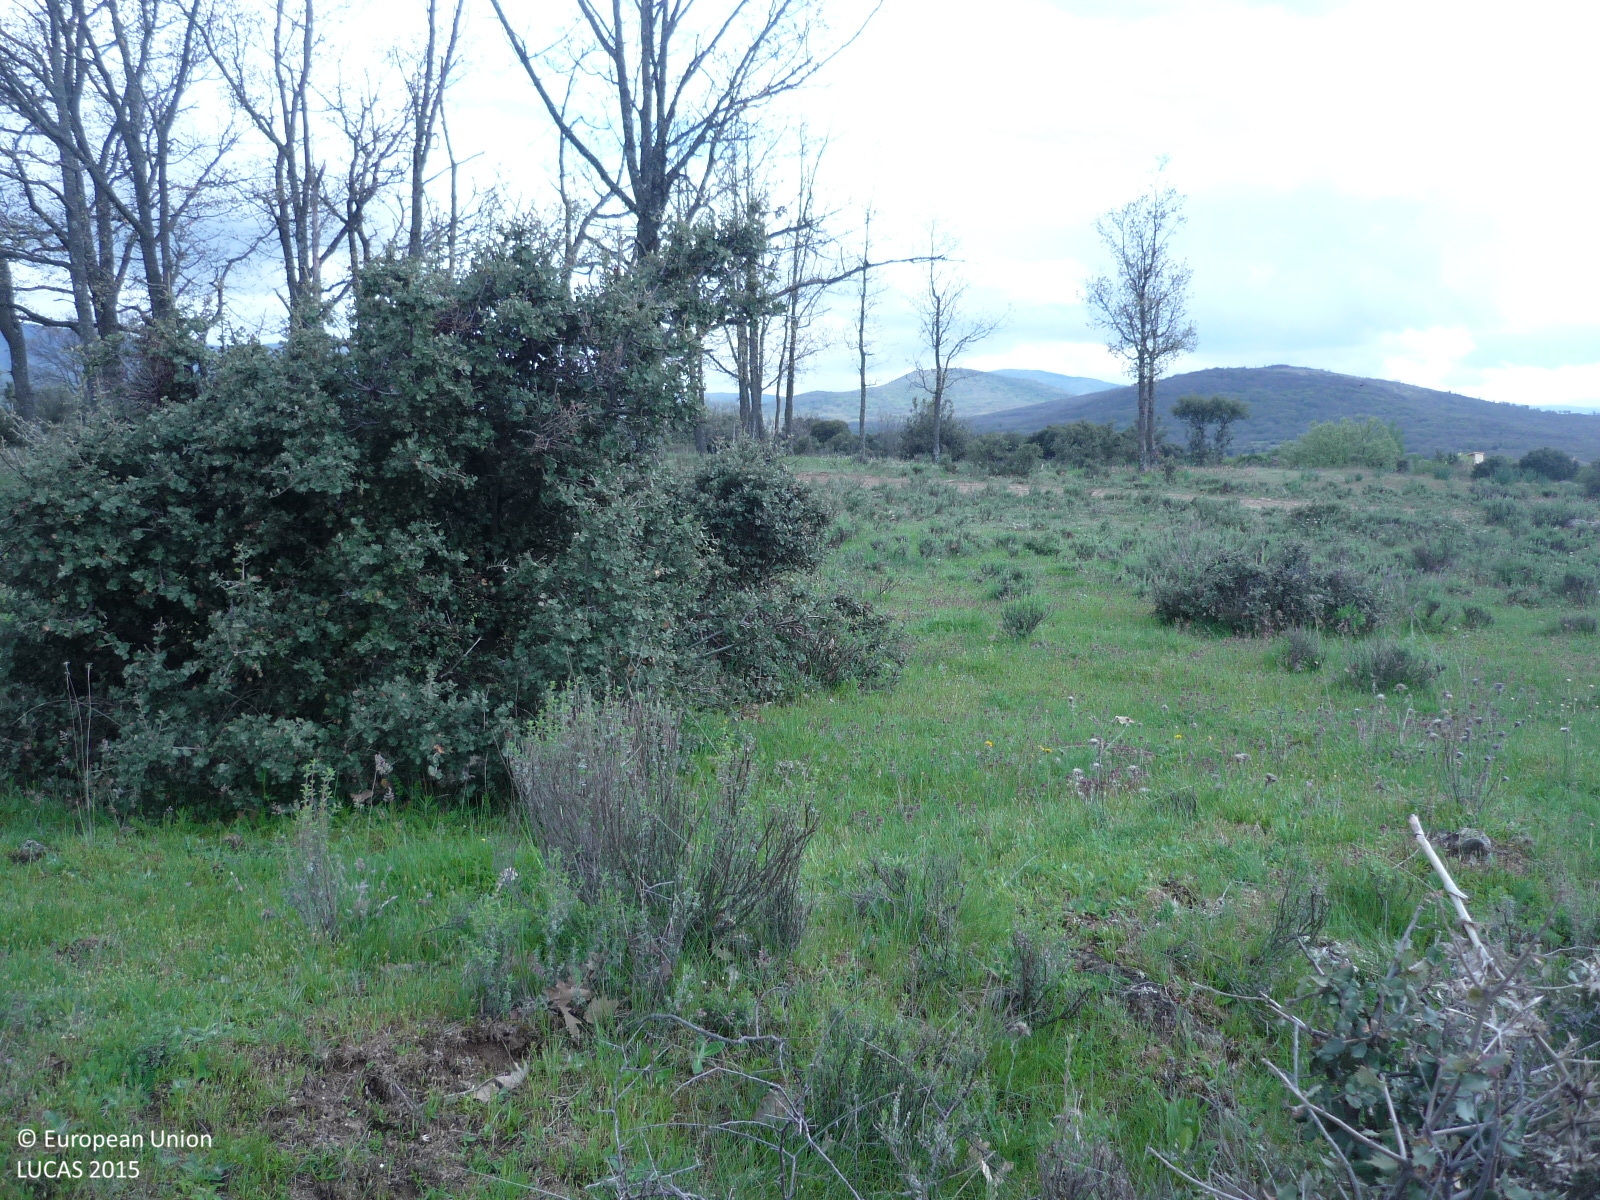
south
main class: Grassland
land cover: Grassland with sparse tree/shrub cover
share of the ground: > 75 %
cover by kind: herbaceous plants 85 %, shrubs 10 %, broadleaved forest trees 5 %
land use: Agriculture (excluding fallow land and kitchen gardens)
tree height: < 5 m
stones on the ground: < 10 %
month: April
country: ES
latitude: 40.9505
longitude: -3.6938
